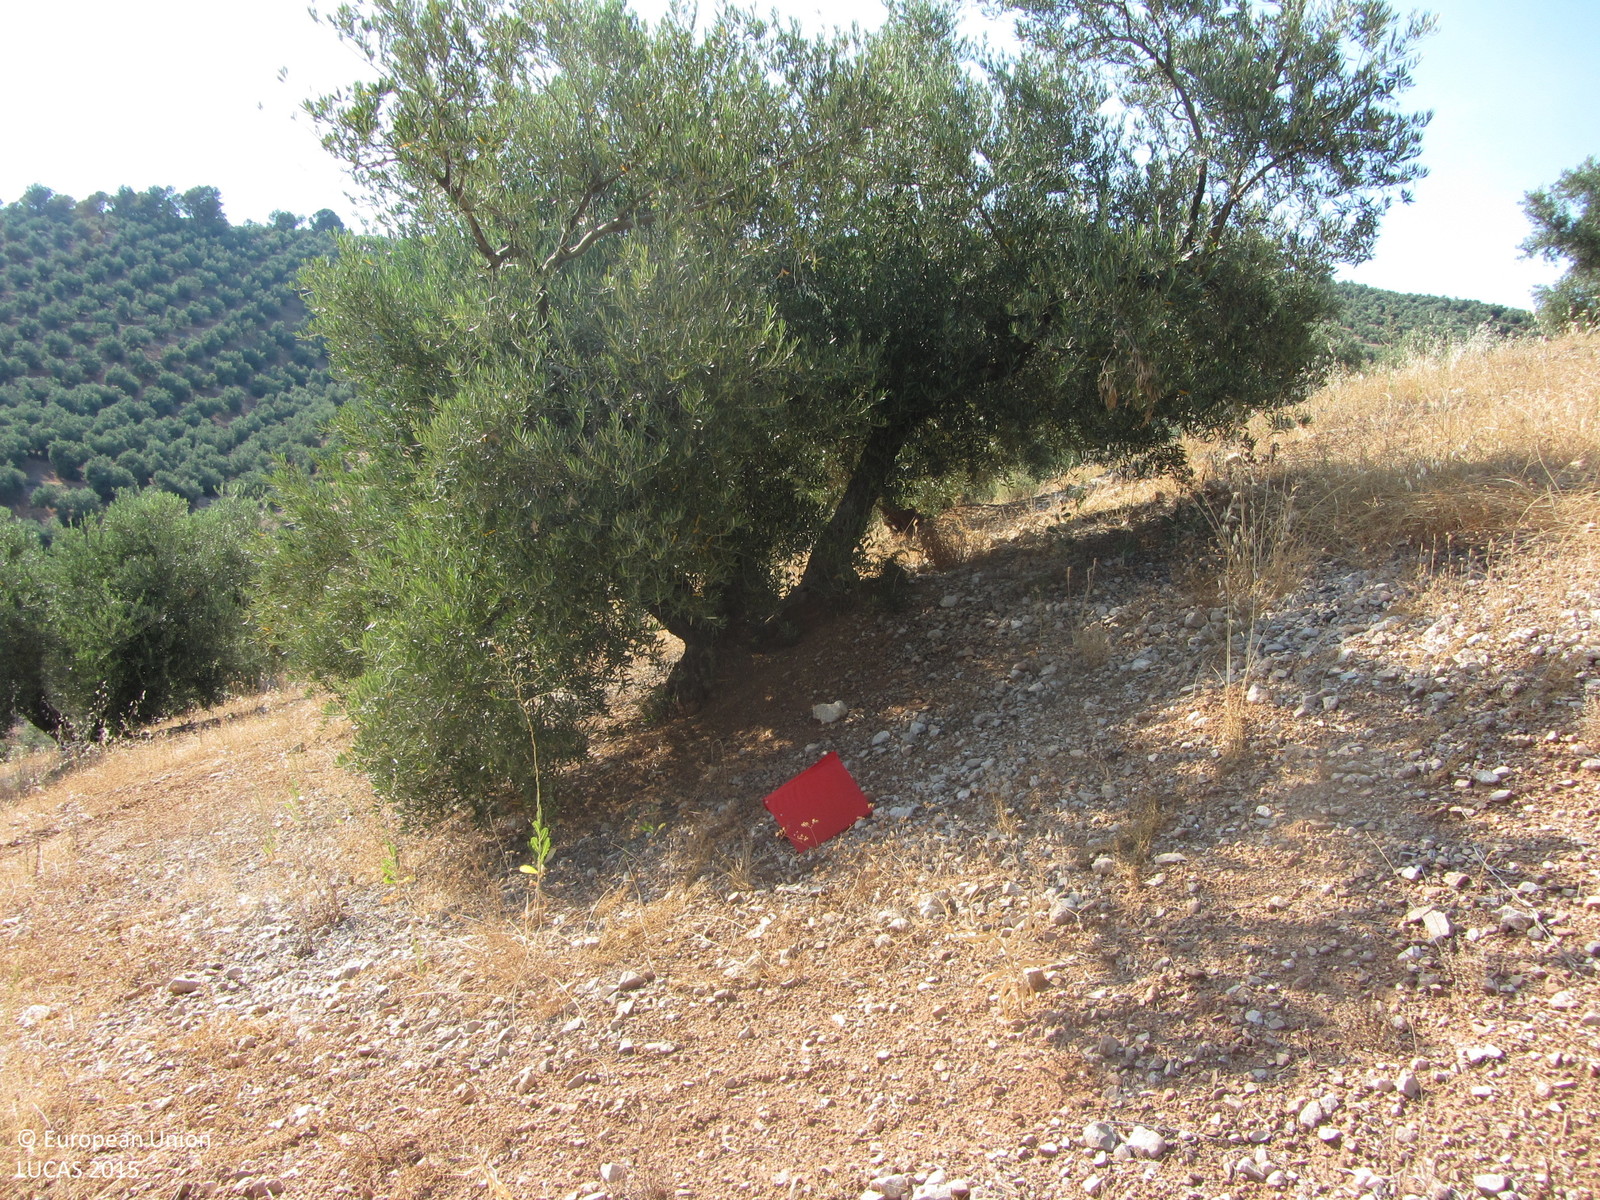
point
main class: Cropland
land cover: Olive groves
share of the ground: 25 - 50 %
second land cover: Spontaneously vegetated surfaces
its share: 10 - 25 %
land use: Agriculture (excluding fallow land and kitchen gardens)
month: June
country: ES
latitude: 38.2850
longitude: -2.8376
